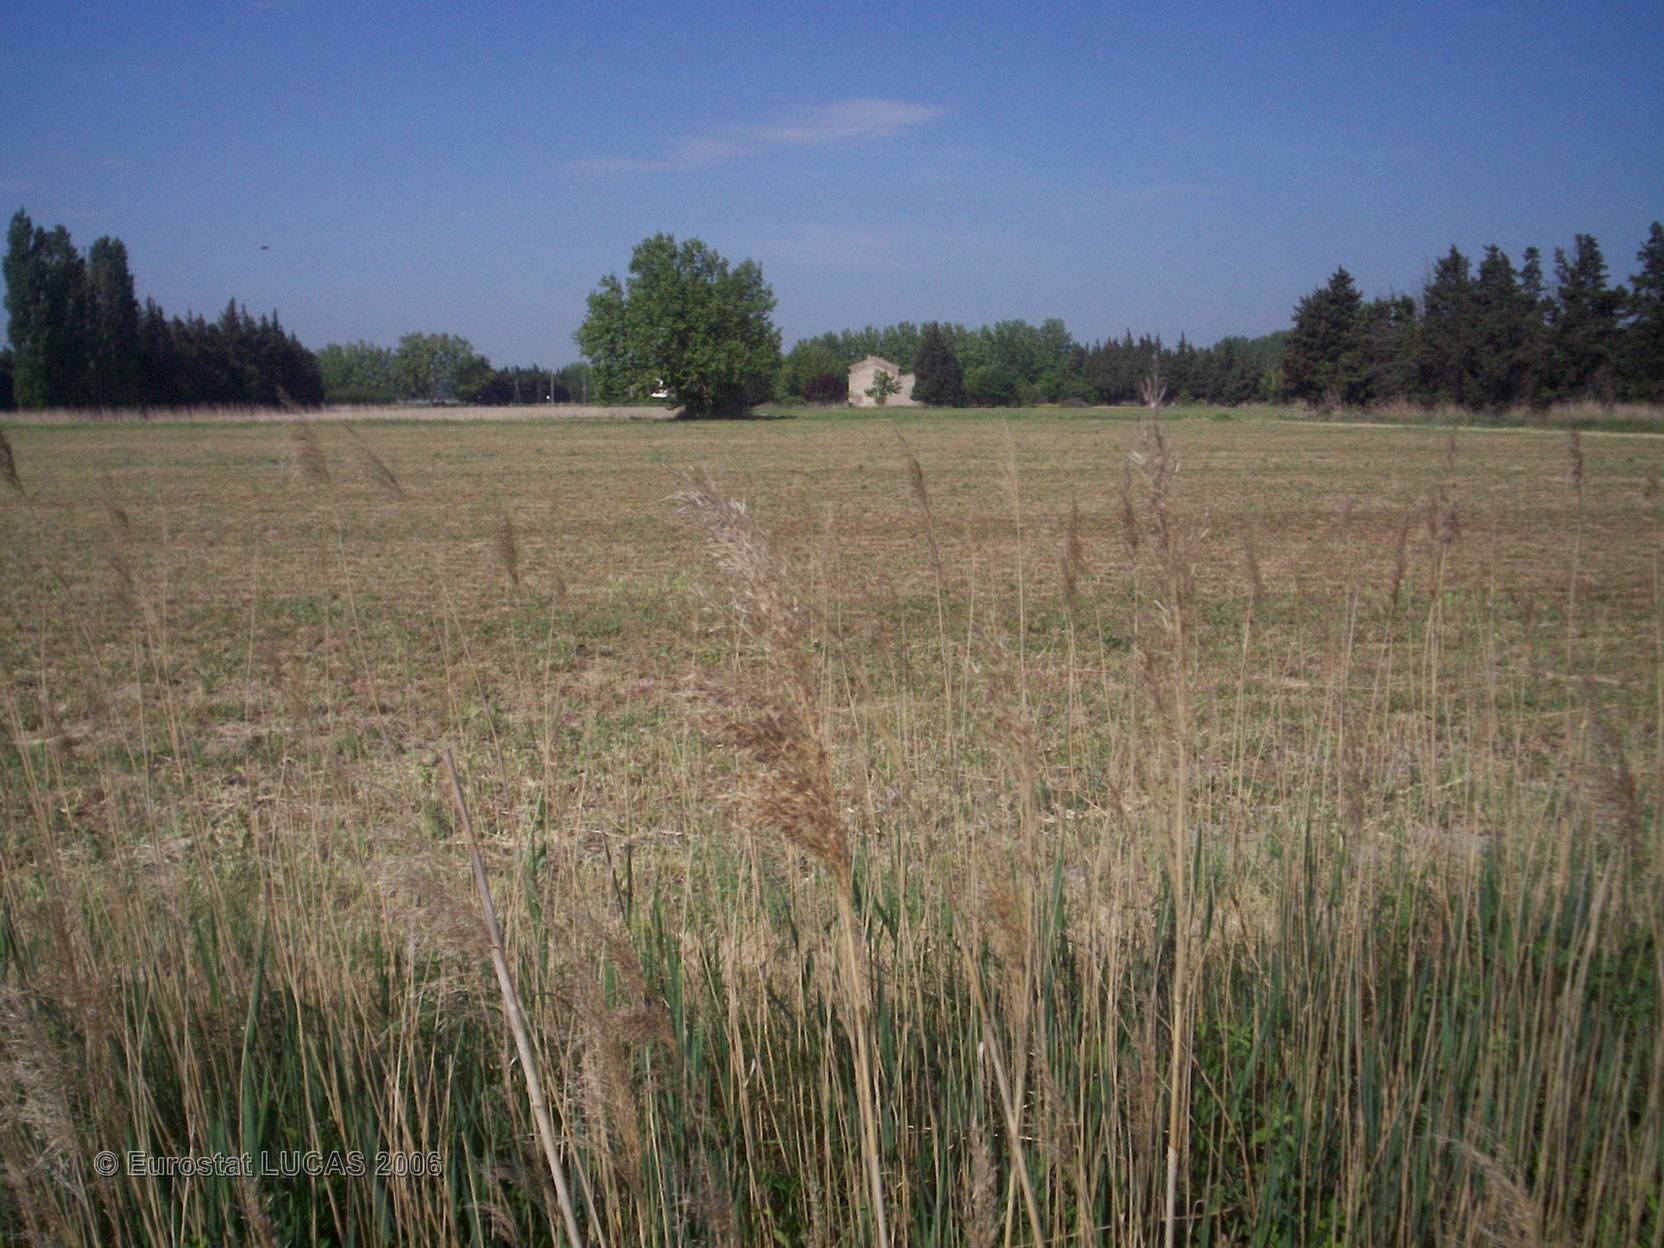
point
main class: Grassland
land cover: Grassland without tree/shrub cover
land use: Agriculture (excluding fallow land and kitchen gardens)
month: May
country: FR
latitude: 44.0651
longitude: 4.9520
